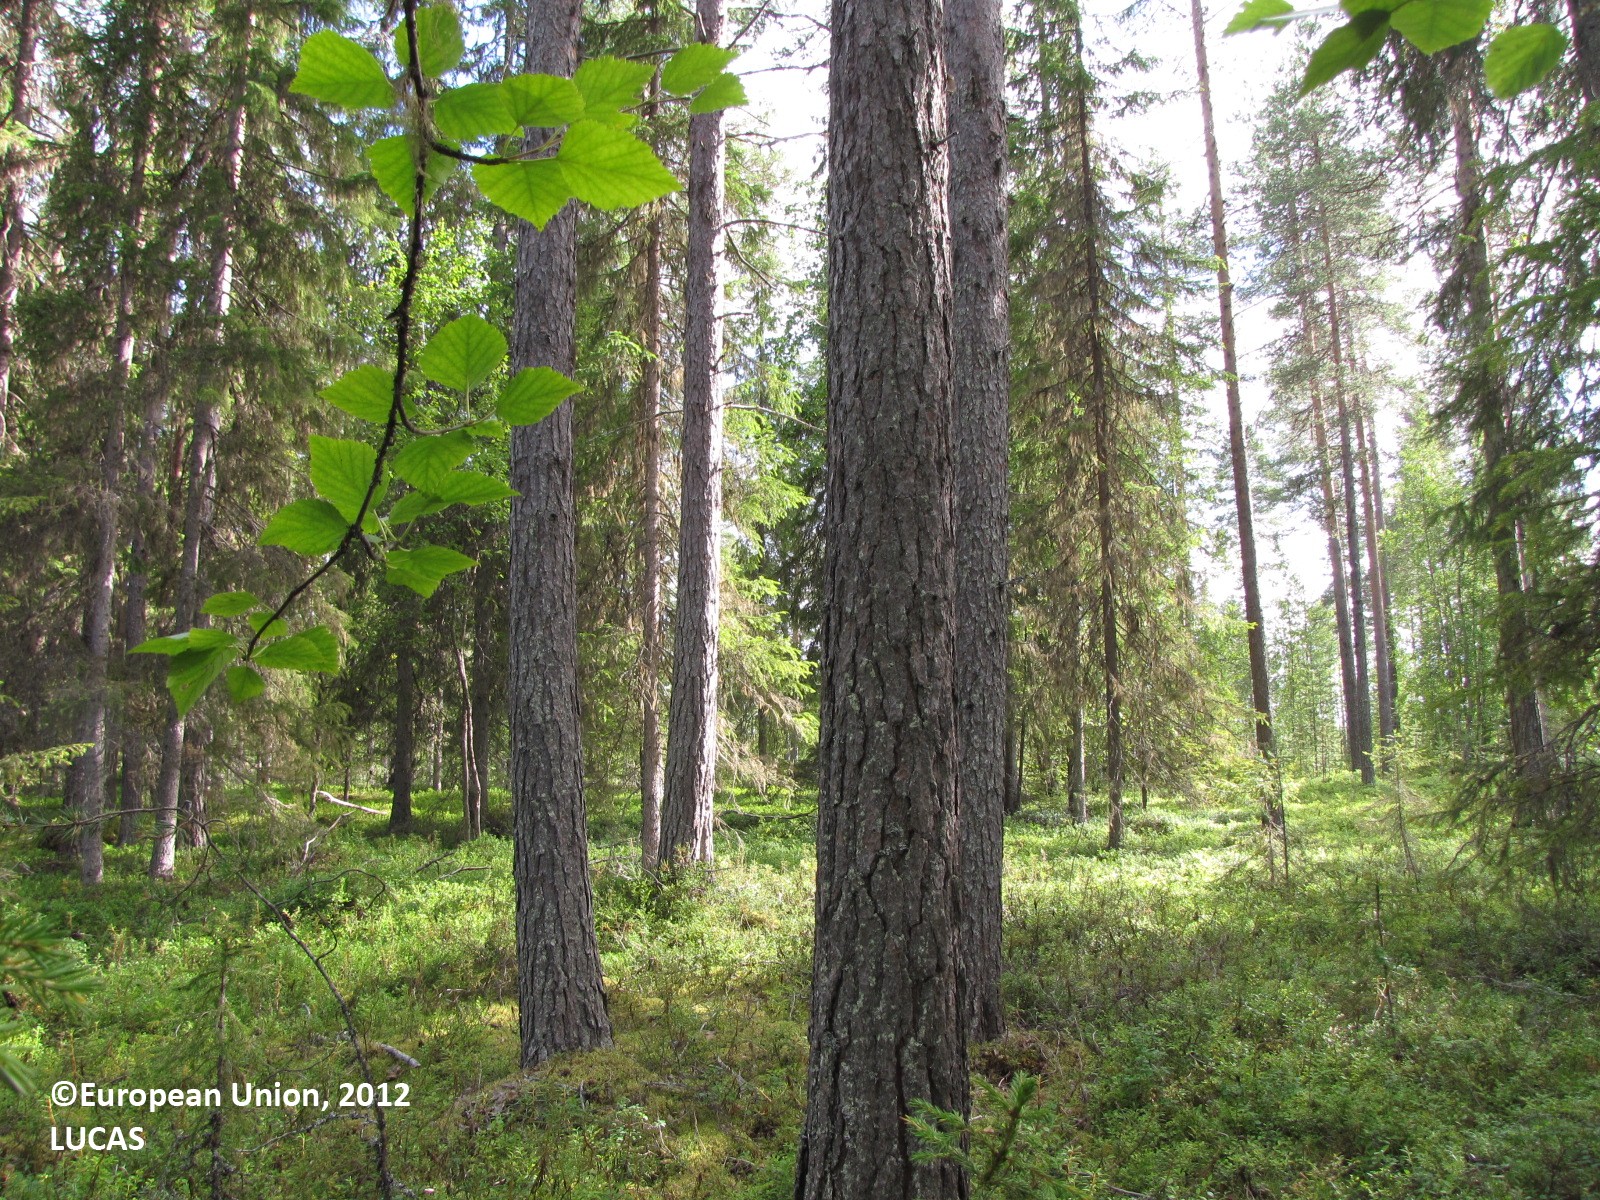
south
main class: Woodland
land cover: Other coniferous woodland
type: boreal forest
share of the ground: 25 - 50 %
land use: Forestry
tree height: > 5 m
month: August
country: FI
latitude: 66.8626
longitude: 25.1724
